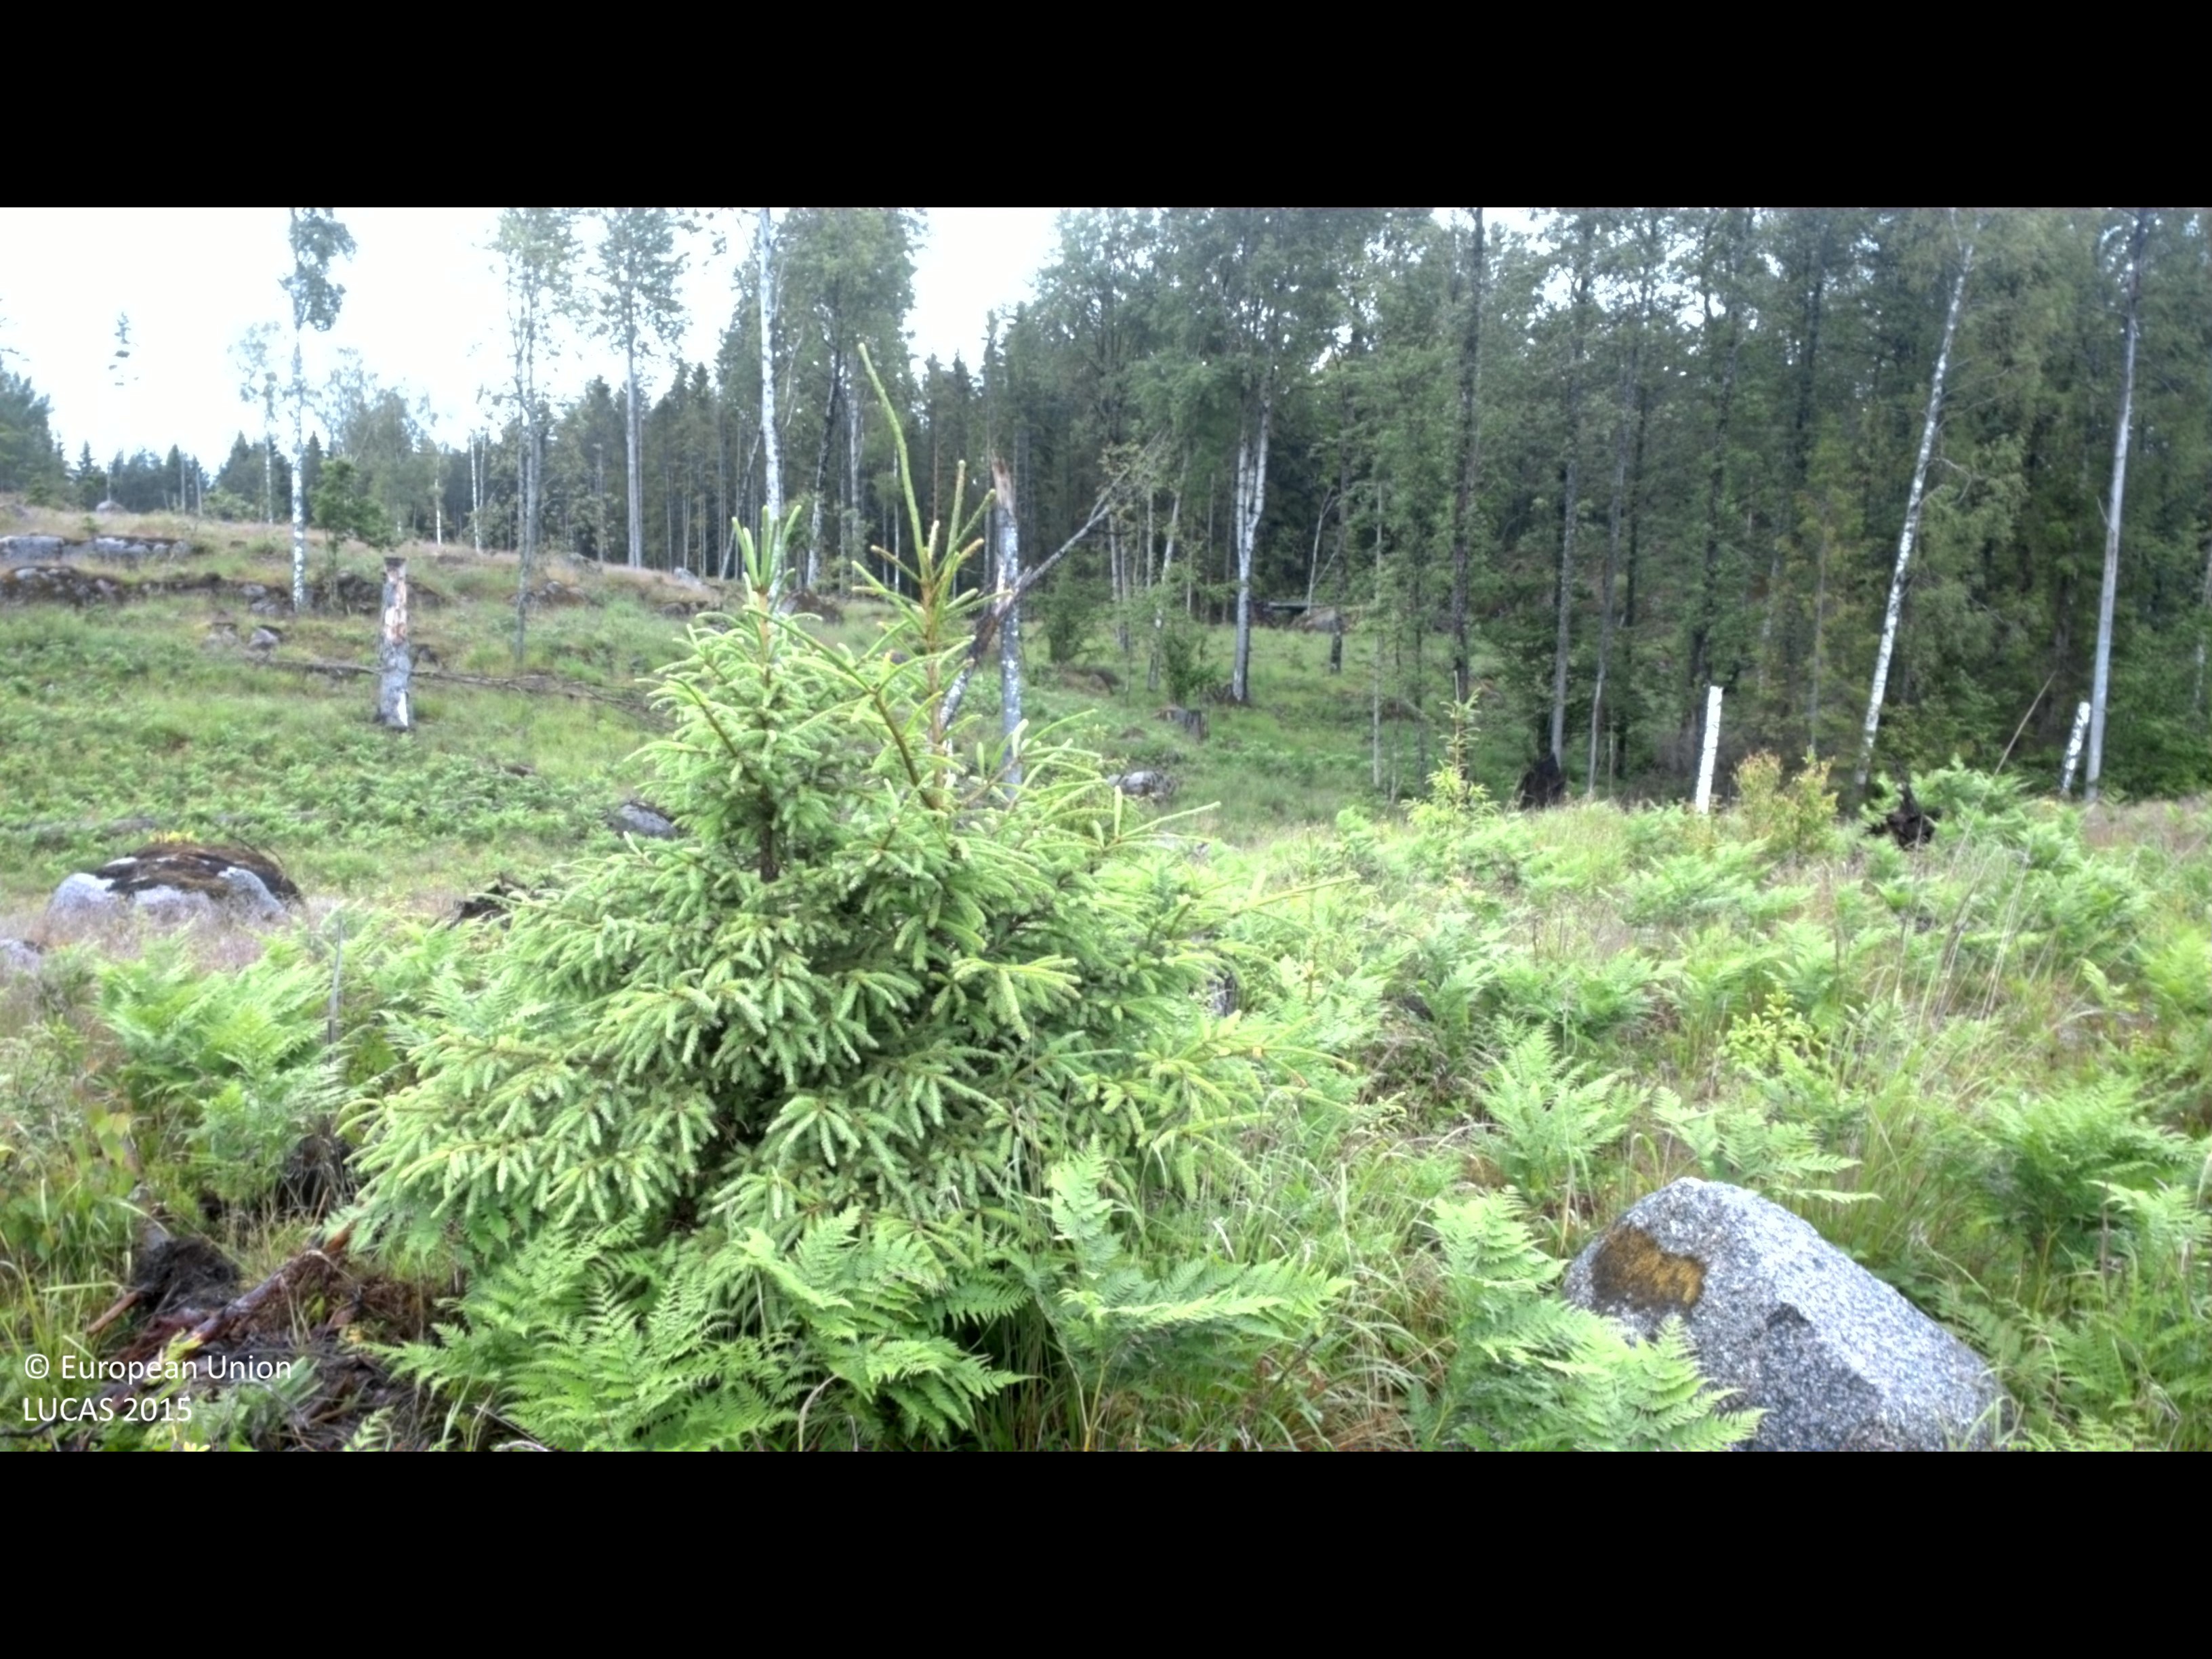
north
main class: Woodland
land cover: Spruce dominated coniferous woodland
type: boreal forest
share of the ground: 10 - 25 %
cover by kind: herbaceous plants 70 %, coniferous forest trees 15 %, shrubs 15 %
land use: Forestry
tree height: < 5 m
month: June
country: SE
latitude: 58.0592
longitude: 16.1824
